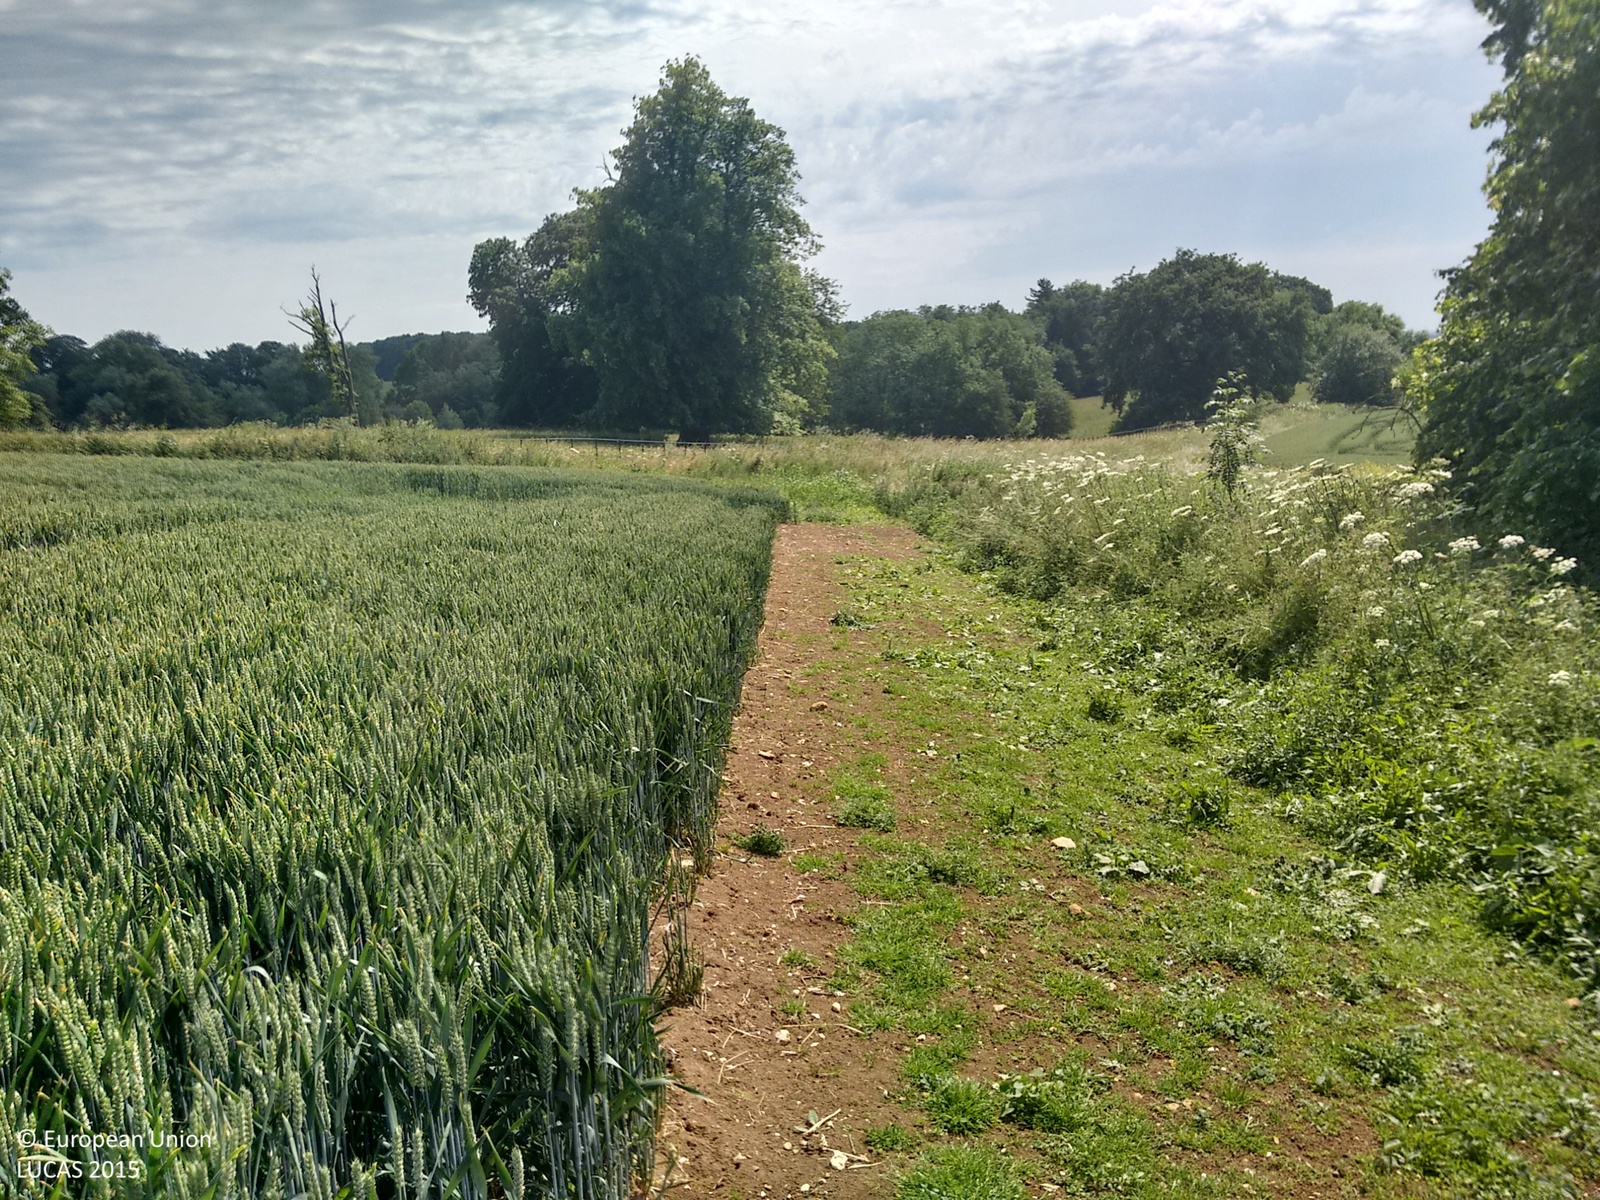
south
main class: Cropland
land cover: Common wheat
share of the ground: > 75 %
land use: Agriculture (excluding fallow land and kitchen gardens)
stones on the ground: < 10 %
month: July
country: GB
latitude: 53.9381
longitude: -0.7484
